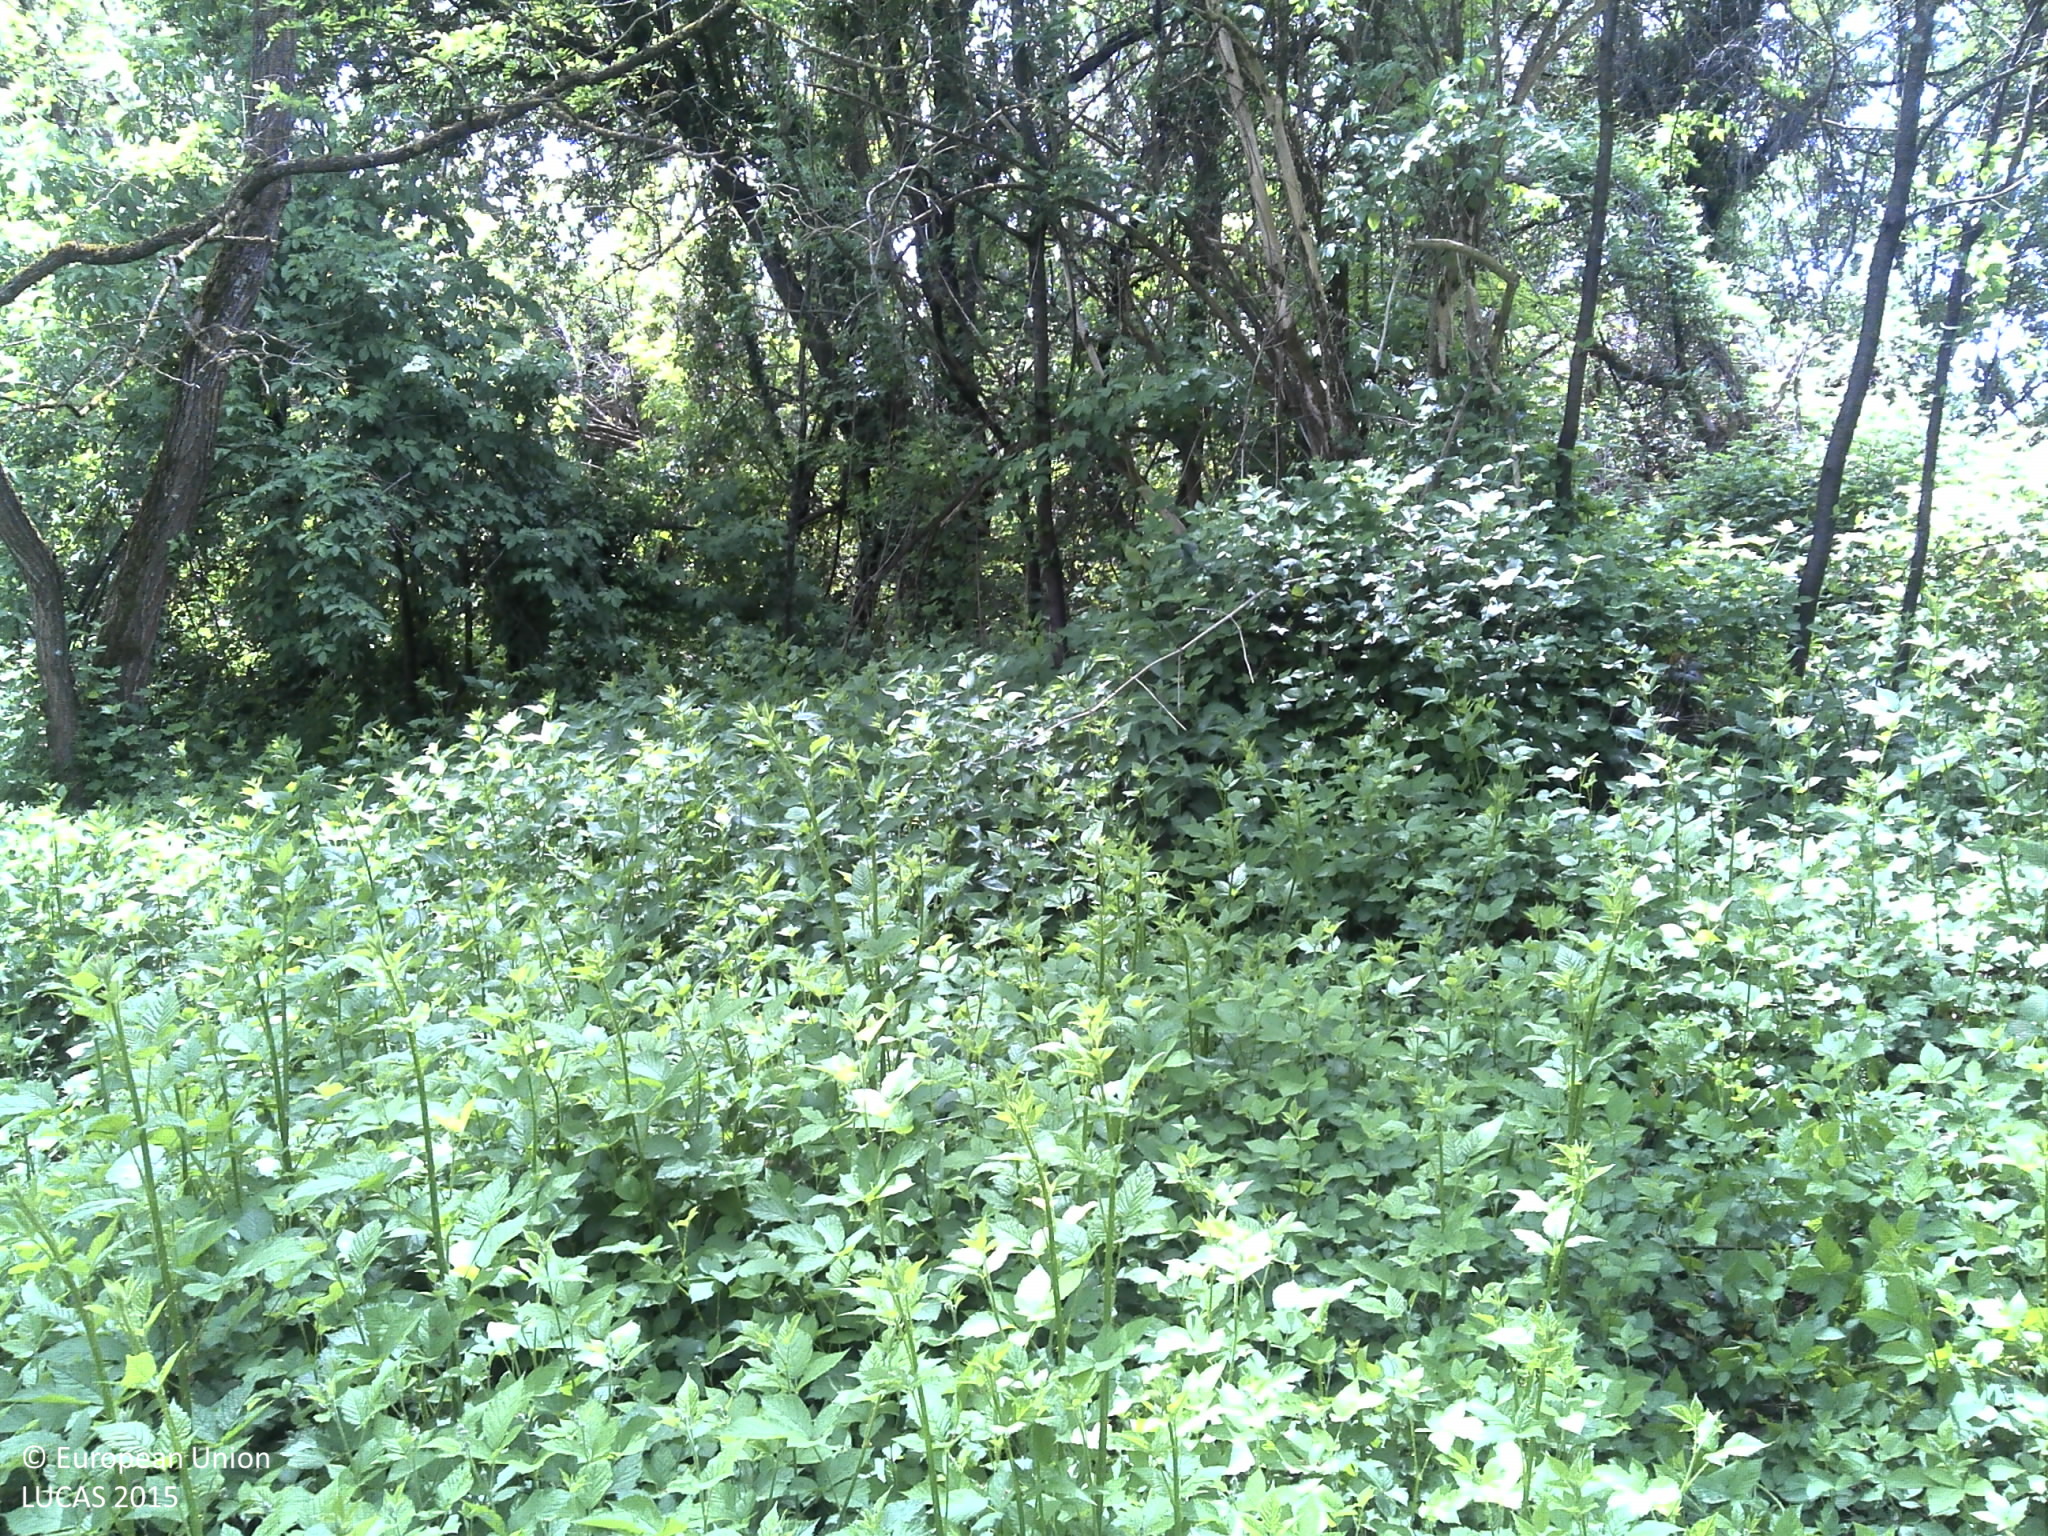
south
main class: Woodland
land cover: Broadleaved woodland
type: acidophilous oak and oak-birch forest
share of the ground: > 75 %
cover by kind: broadleaved forest trees 80 %, lichens and mosses 20 %
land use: Forestry
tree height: > 5 m
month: May
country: HR
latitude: 45.3372
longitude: 18.1068
